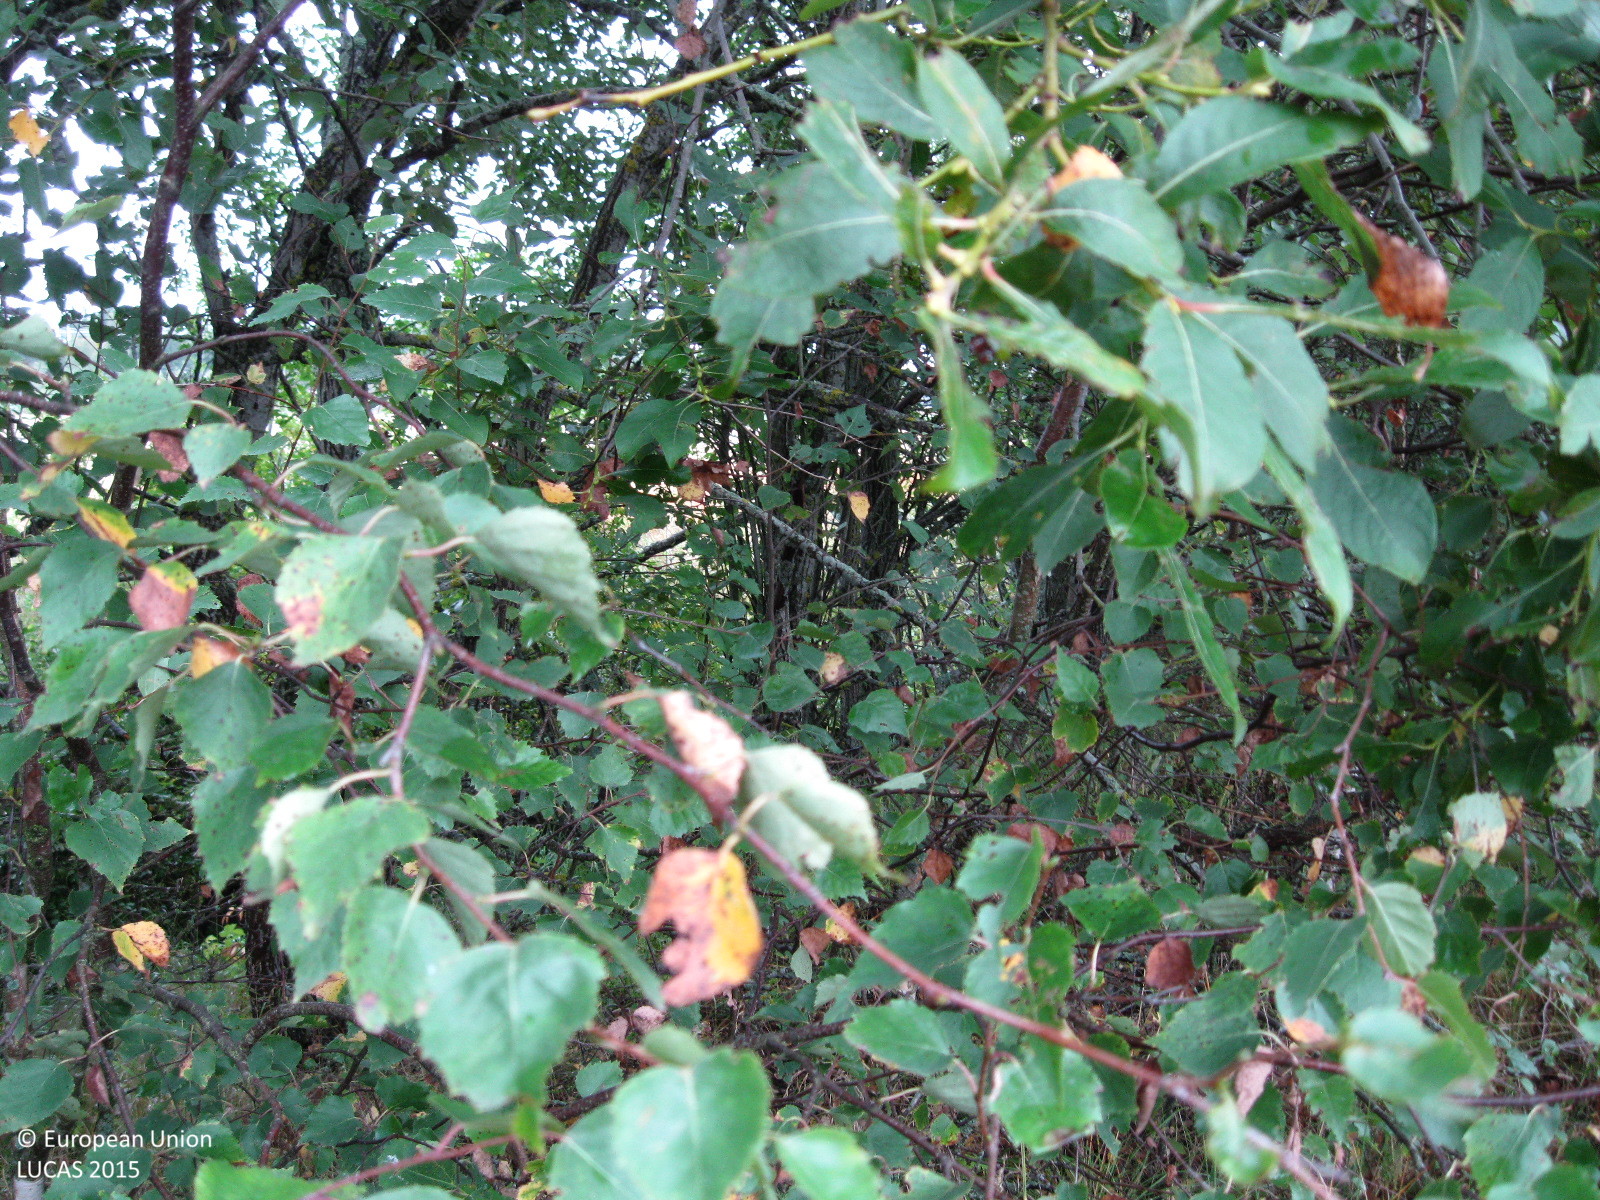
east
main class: Cropland
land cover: Oats
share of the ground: > 75 %
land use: Agriculture (excluding fallow land and kitchen gardens)
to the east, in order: Oats; Broadleaved woodland; Rivers and streams; Broadleaved woodland; Spontaneously vegetated surfaces; Oats
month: September
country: FI
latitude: 60.4540
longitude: 24.6724
